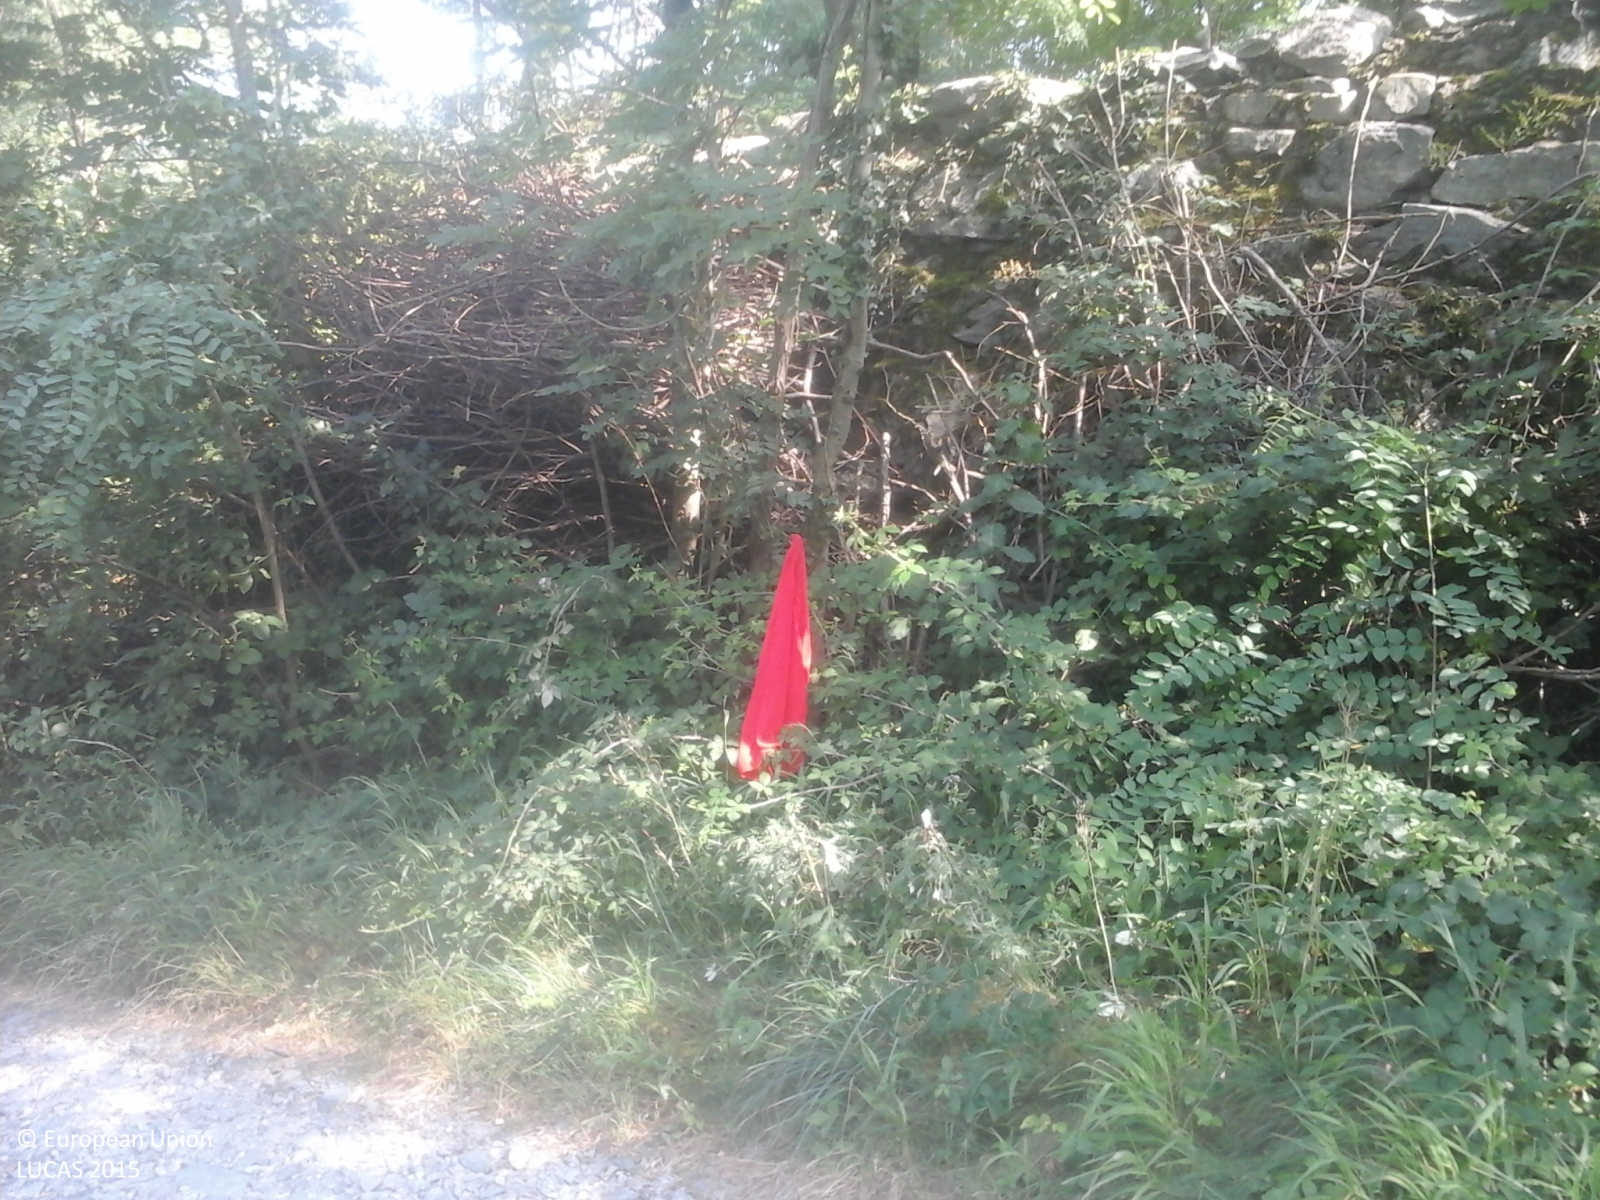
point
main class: Woodland
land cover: Broadleaved woodland
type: thermophilous deciduous forest
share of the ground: > 75 %
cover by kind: broadleaved forest trees 100 %
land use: Forestry
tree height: > 5 m
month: July
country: IT
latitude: 46.2953
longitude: 9.3648
